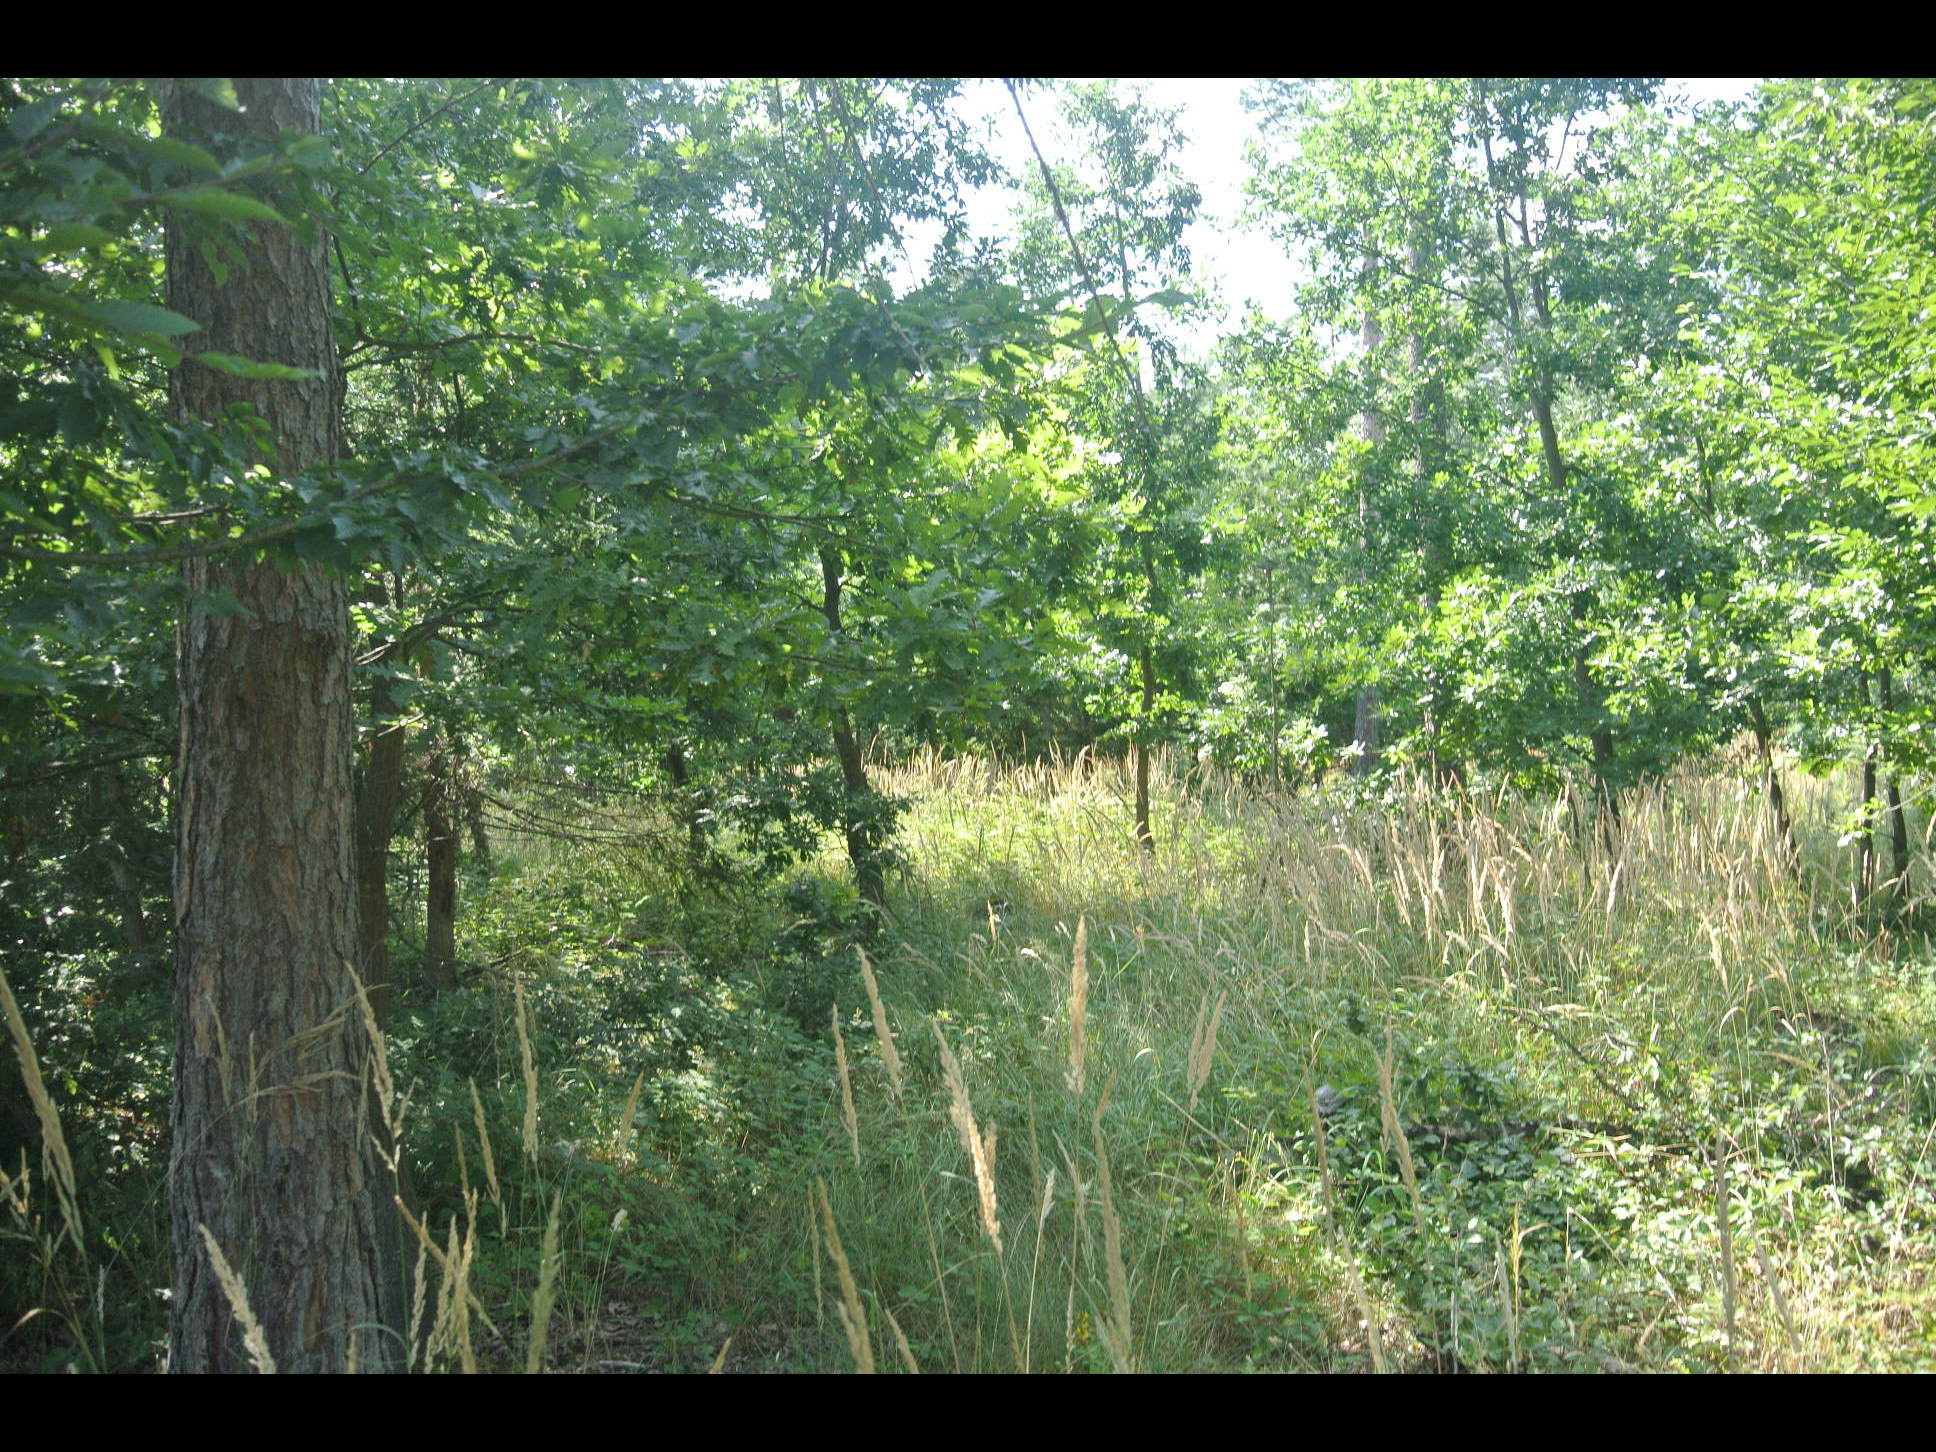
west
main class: Woodland
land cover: Pine dominated mixed woodland
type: acidophilous oak and oak-birch forest
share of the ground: > 75 %
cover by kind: coniferous forest trees 40 %, broadleaved forest trees 35 %, herbaceous plants 25 %
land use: Forestry
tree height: > 5 m
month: July
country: AT
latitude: 47.5442
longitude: 16.5009
